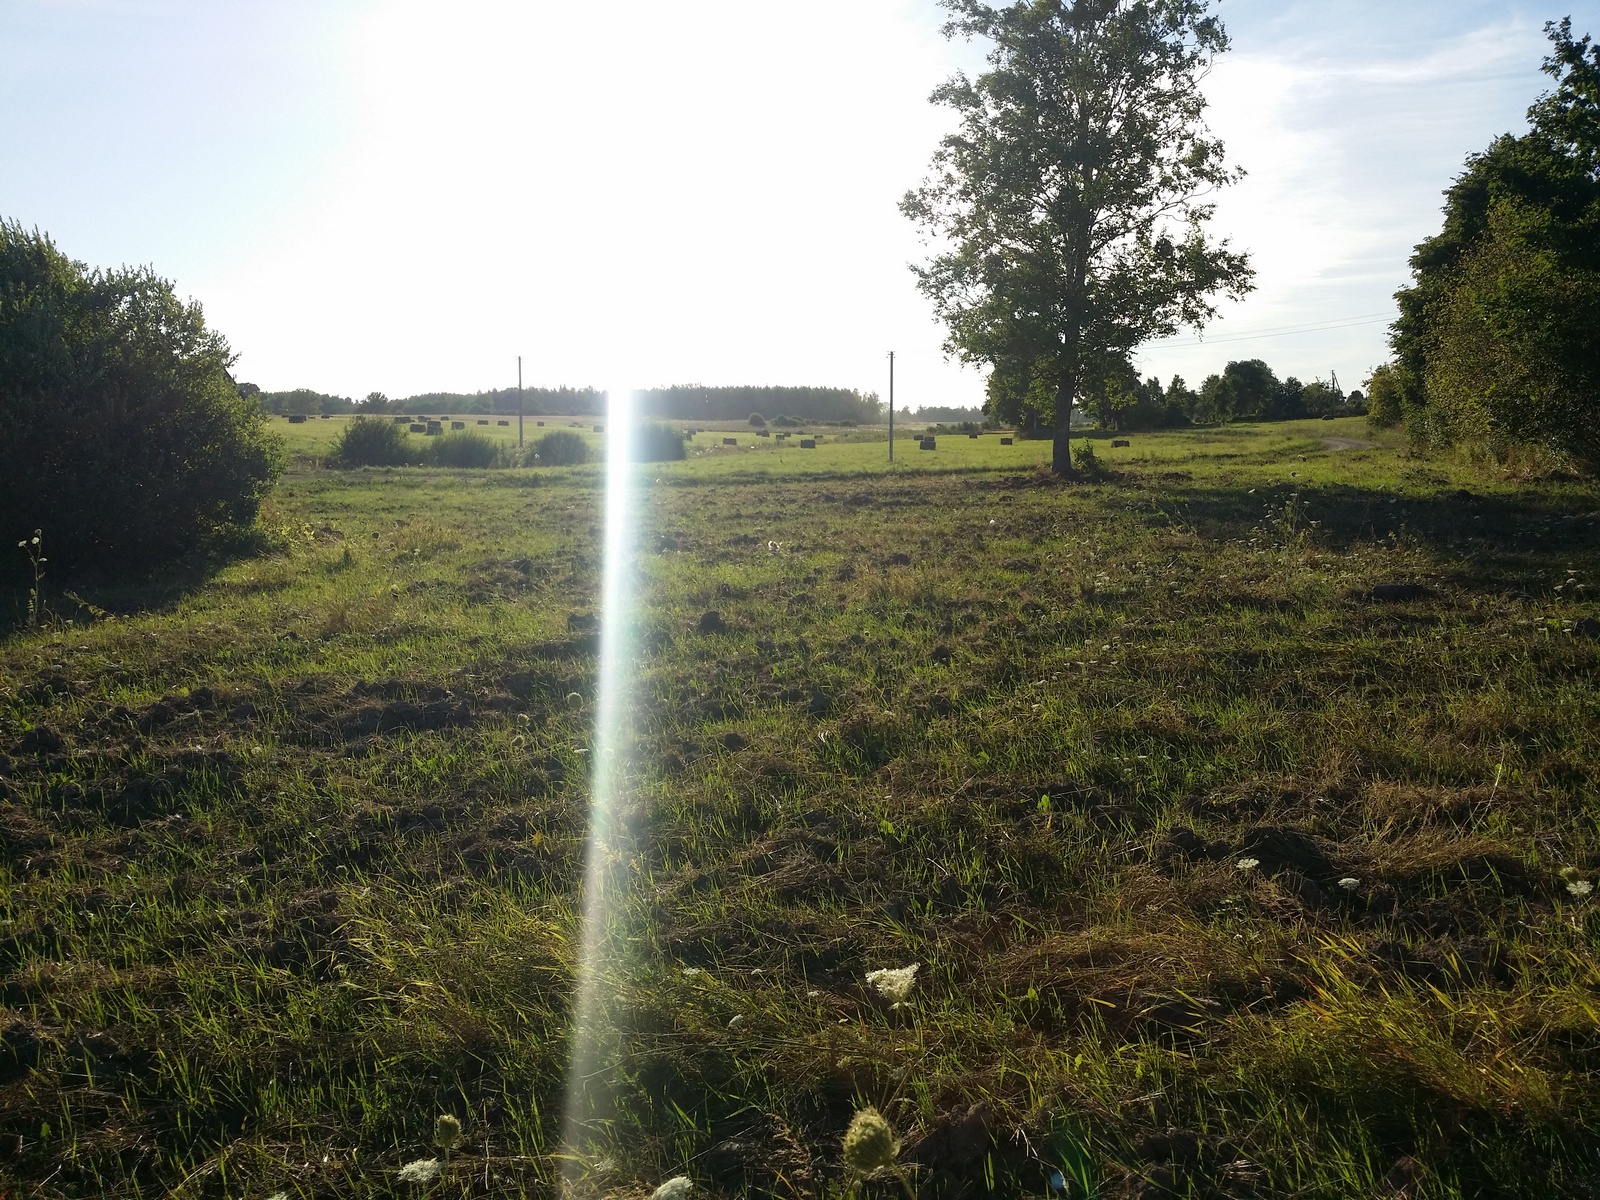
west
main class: Grassland
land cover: Grassland without tree/shrub cover
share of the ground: > 75 %
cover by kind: herbaceous plants 95 %, unconsolidated bare surface 5 %
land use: Agriculture (excluding fallow land and kitchen gardens)
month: August
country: LV
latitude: 57.1253
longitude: 27.6748
